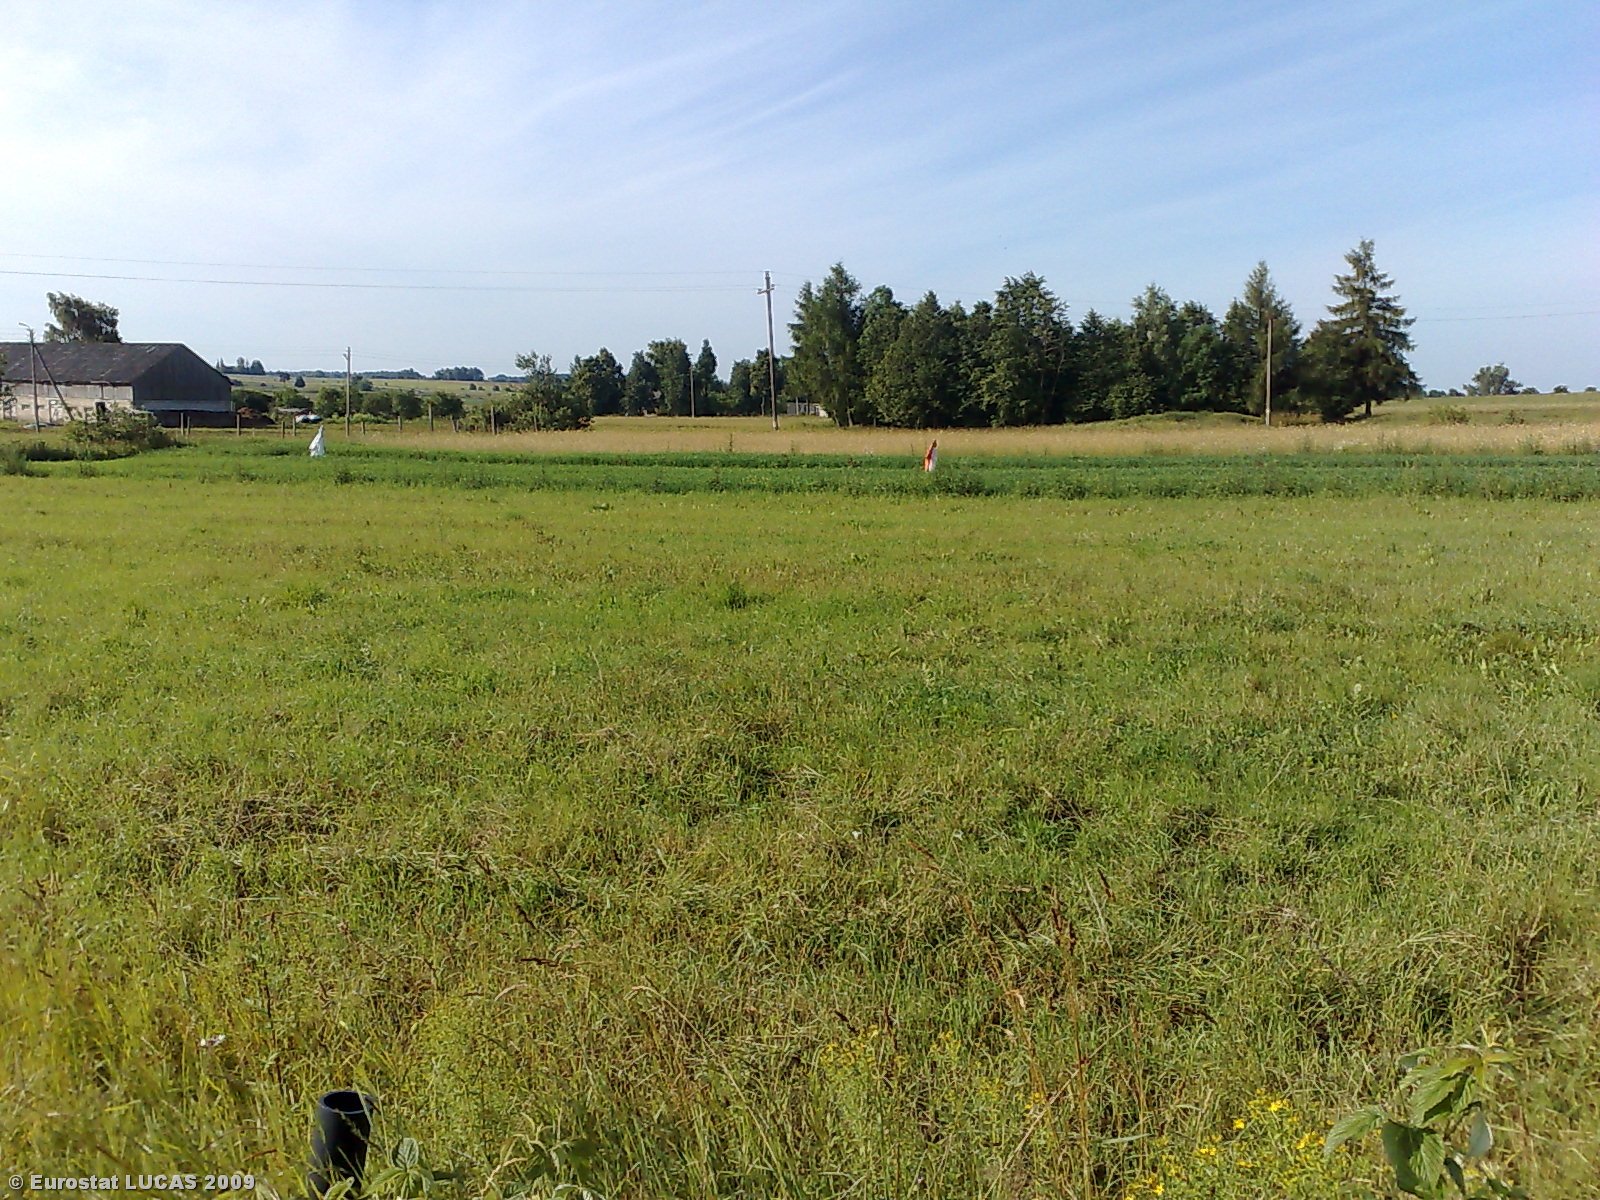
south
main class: Grassland
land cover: Grassland without tree/shrub cover
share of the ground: > 75 %
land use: Agriculture (excluding fallow land and kitchen gardens)
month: July
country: LT
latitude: 55.8296
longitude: 22.8534
